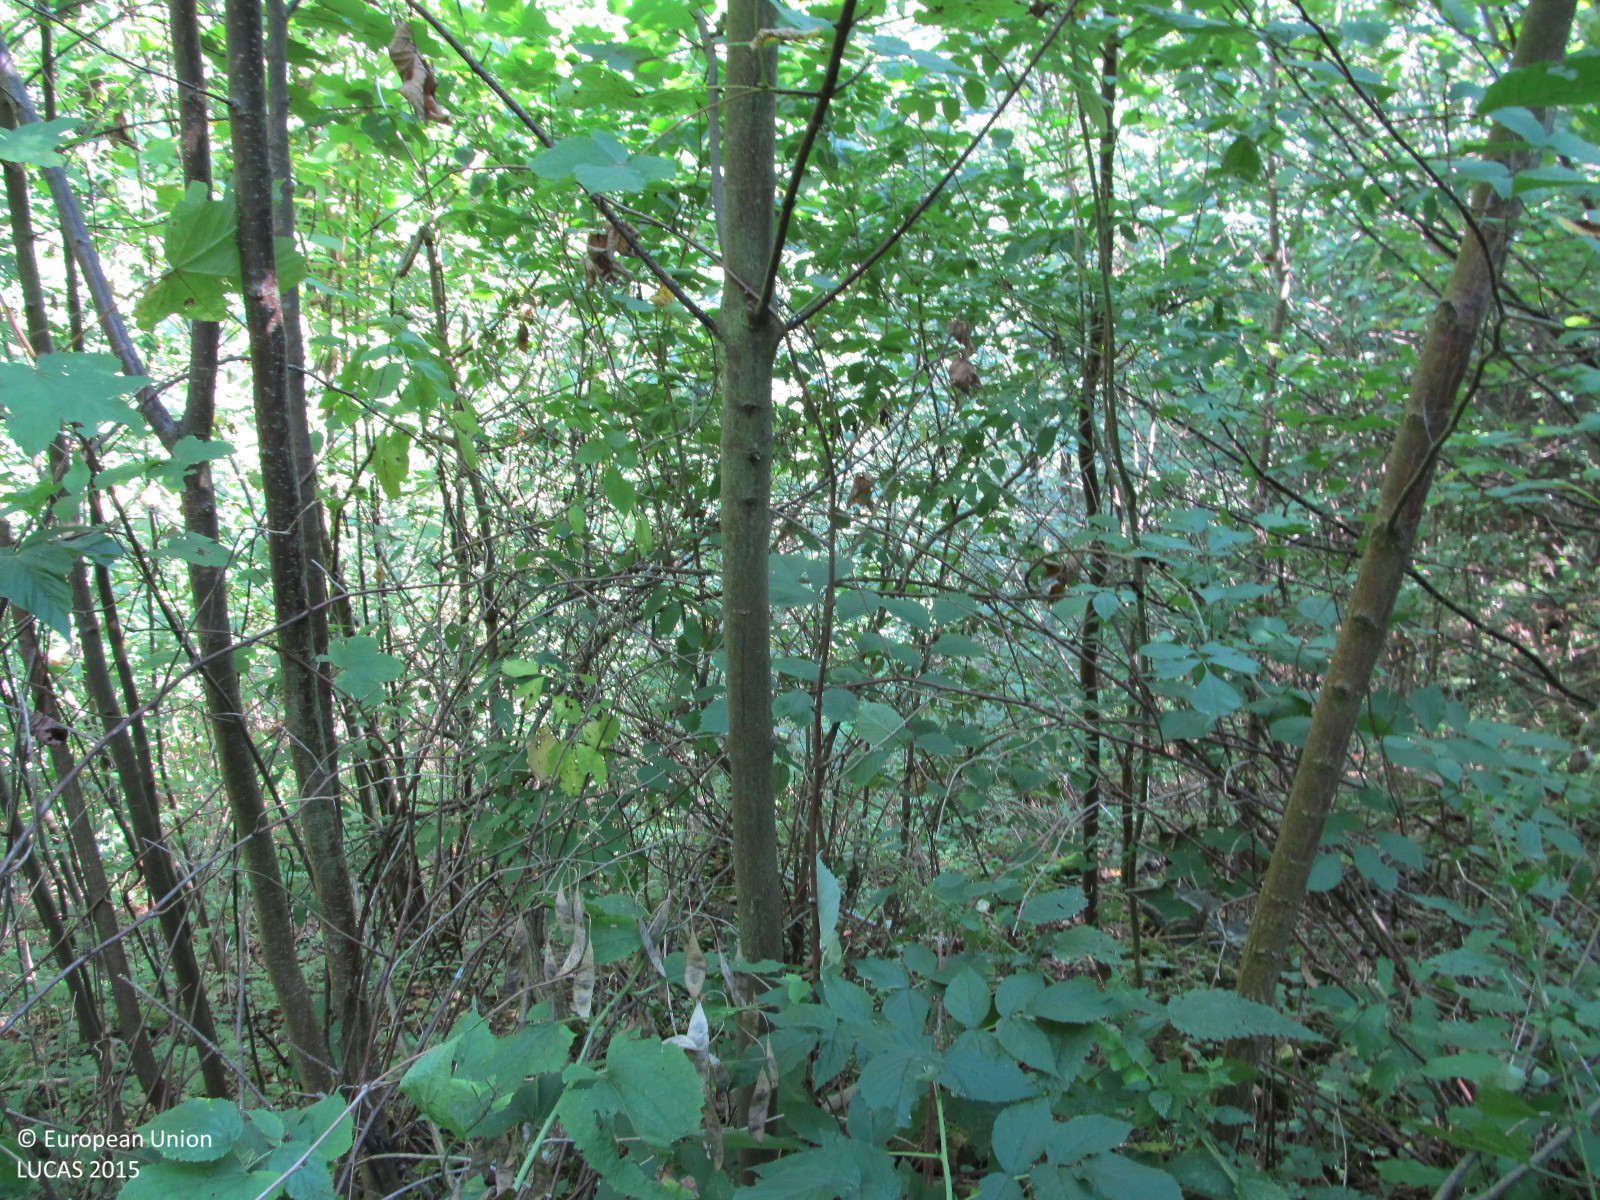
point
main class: Woodland
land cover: Broadleaved woodland
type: hemiboreal forest and nemoral coniferous forest and mixed broadleaved-coniferous forest
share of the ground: > 75 %
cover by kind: broadleaved forest trees 85 %, shrubs 5 %, herbaceous plants 5 %, unconsolidated bare surface 5 %
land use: Semi-natural and natural areas not in use
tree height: > 5 m
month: August
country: AT
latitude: 48.4520
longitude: 15.3973
